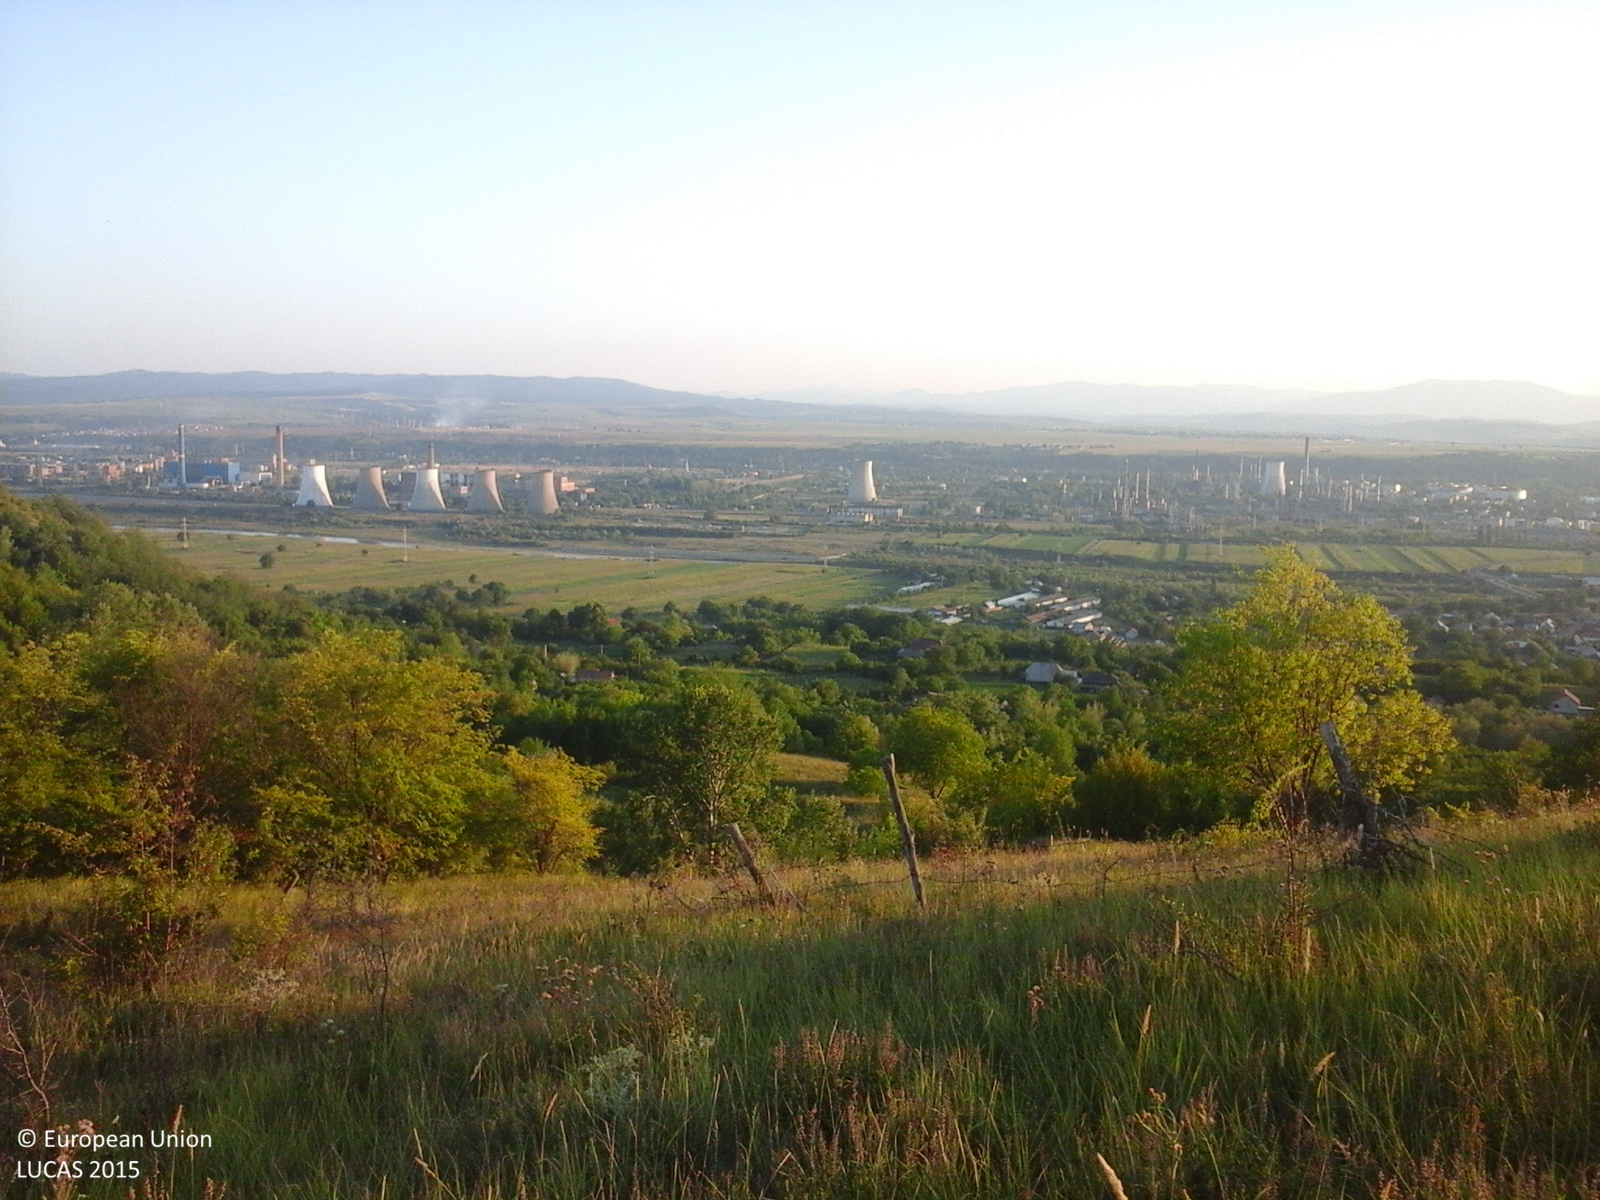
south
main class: Grassland
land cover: Grassland with sparse tree/shrub cover
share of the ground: > 75 %
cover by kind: herbaceous plants 85 %, shrubs 10 %, broadleaved forest trees 5 %
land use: Agriculture (excluding fallow land and kitchen gardens)
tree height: < 5 m
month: August
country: RO
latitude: 46.2719
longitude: 26.8419
